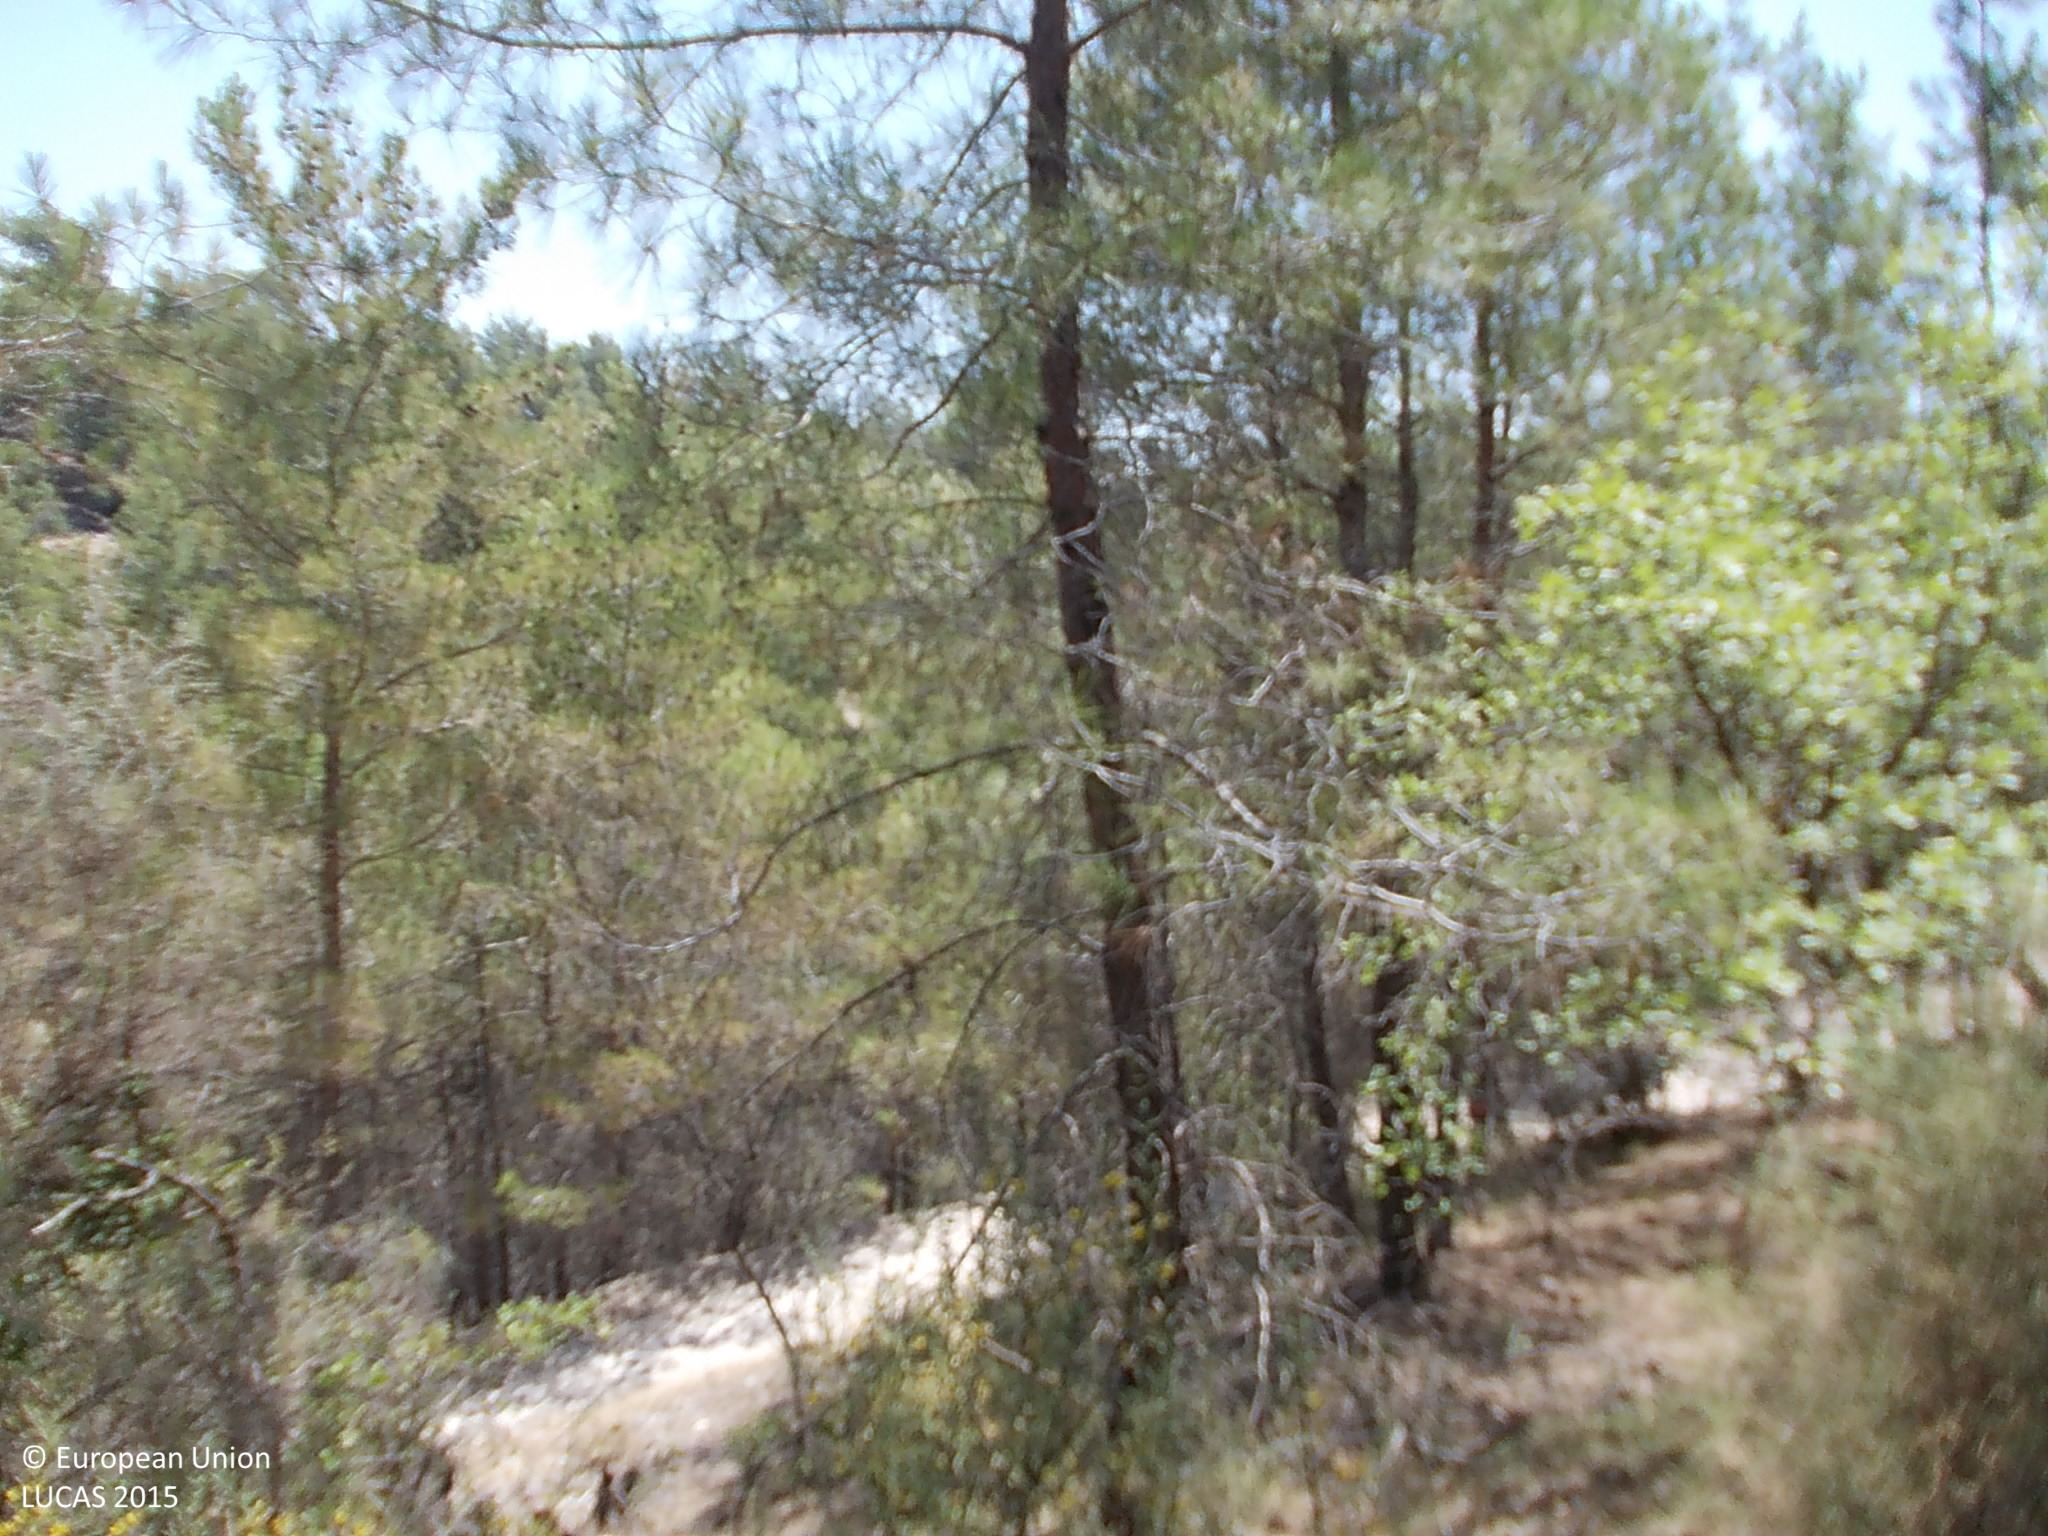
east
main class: Woodland
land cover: Pine dominated coniferous woodland
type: coniferous forest of the mediterranean region
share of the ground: > 75 %
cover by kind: coniferous forest trees 75 %, shrubs 10 %, unconsolidated bare surface 10 %, broadleaved forest trees 5 %
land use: Semi-natural and natural areas not in use
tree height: > 5 m
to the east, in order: Pine dominated coniferous woodland; Tracks; Pine dominated coniferous woodland; Rivers and streams; Pine dominated coniferous woodland; Tracks; Pine dominated coniferous woodland
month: July
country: CY
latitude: 34.7544
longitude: 32.7132
